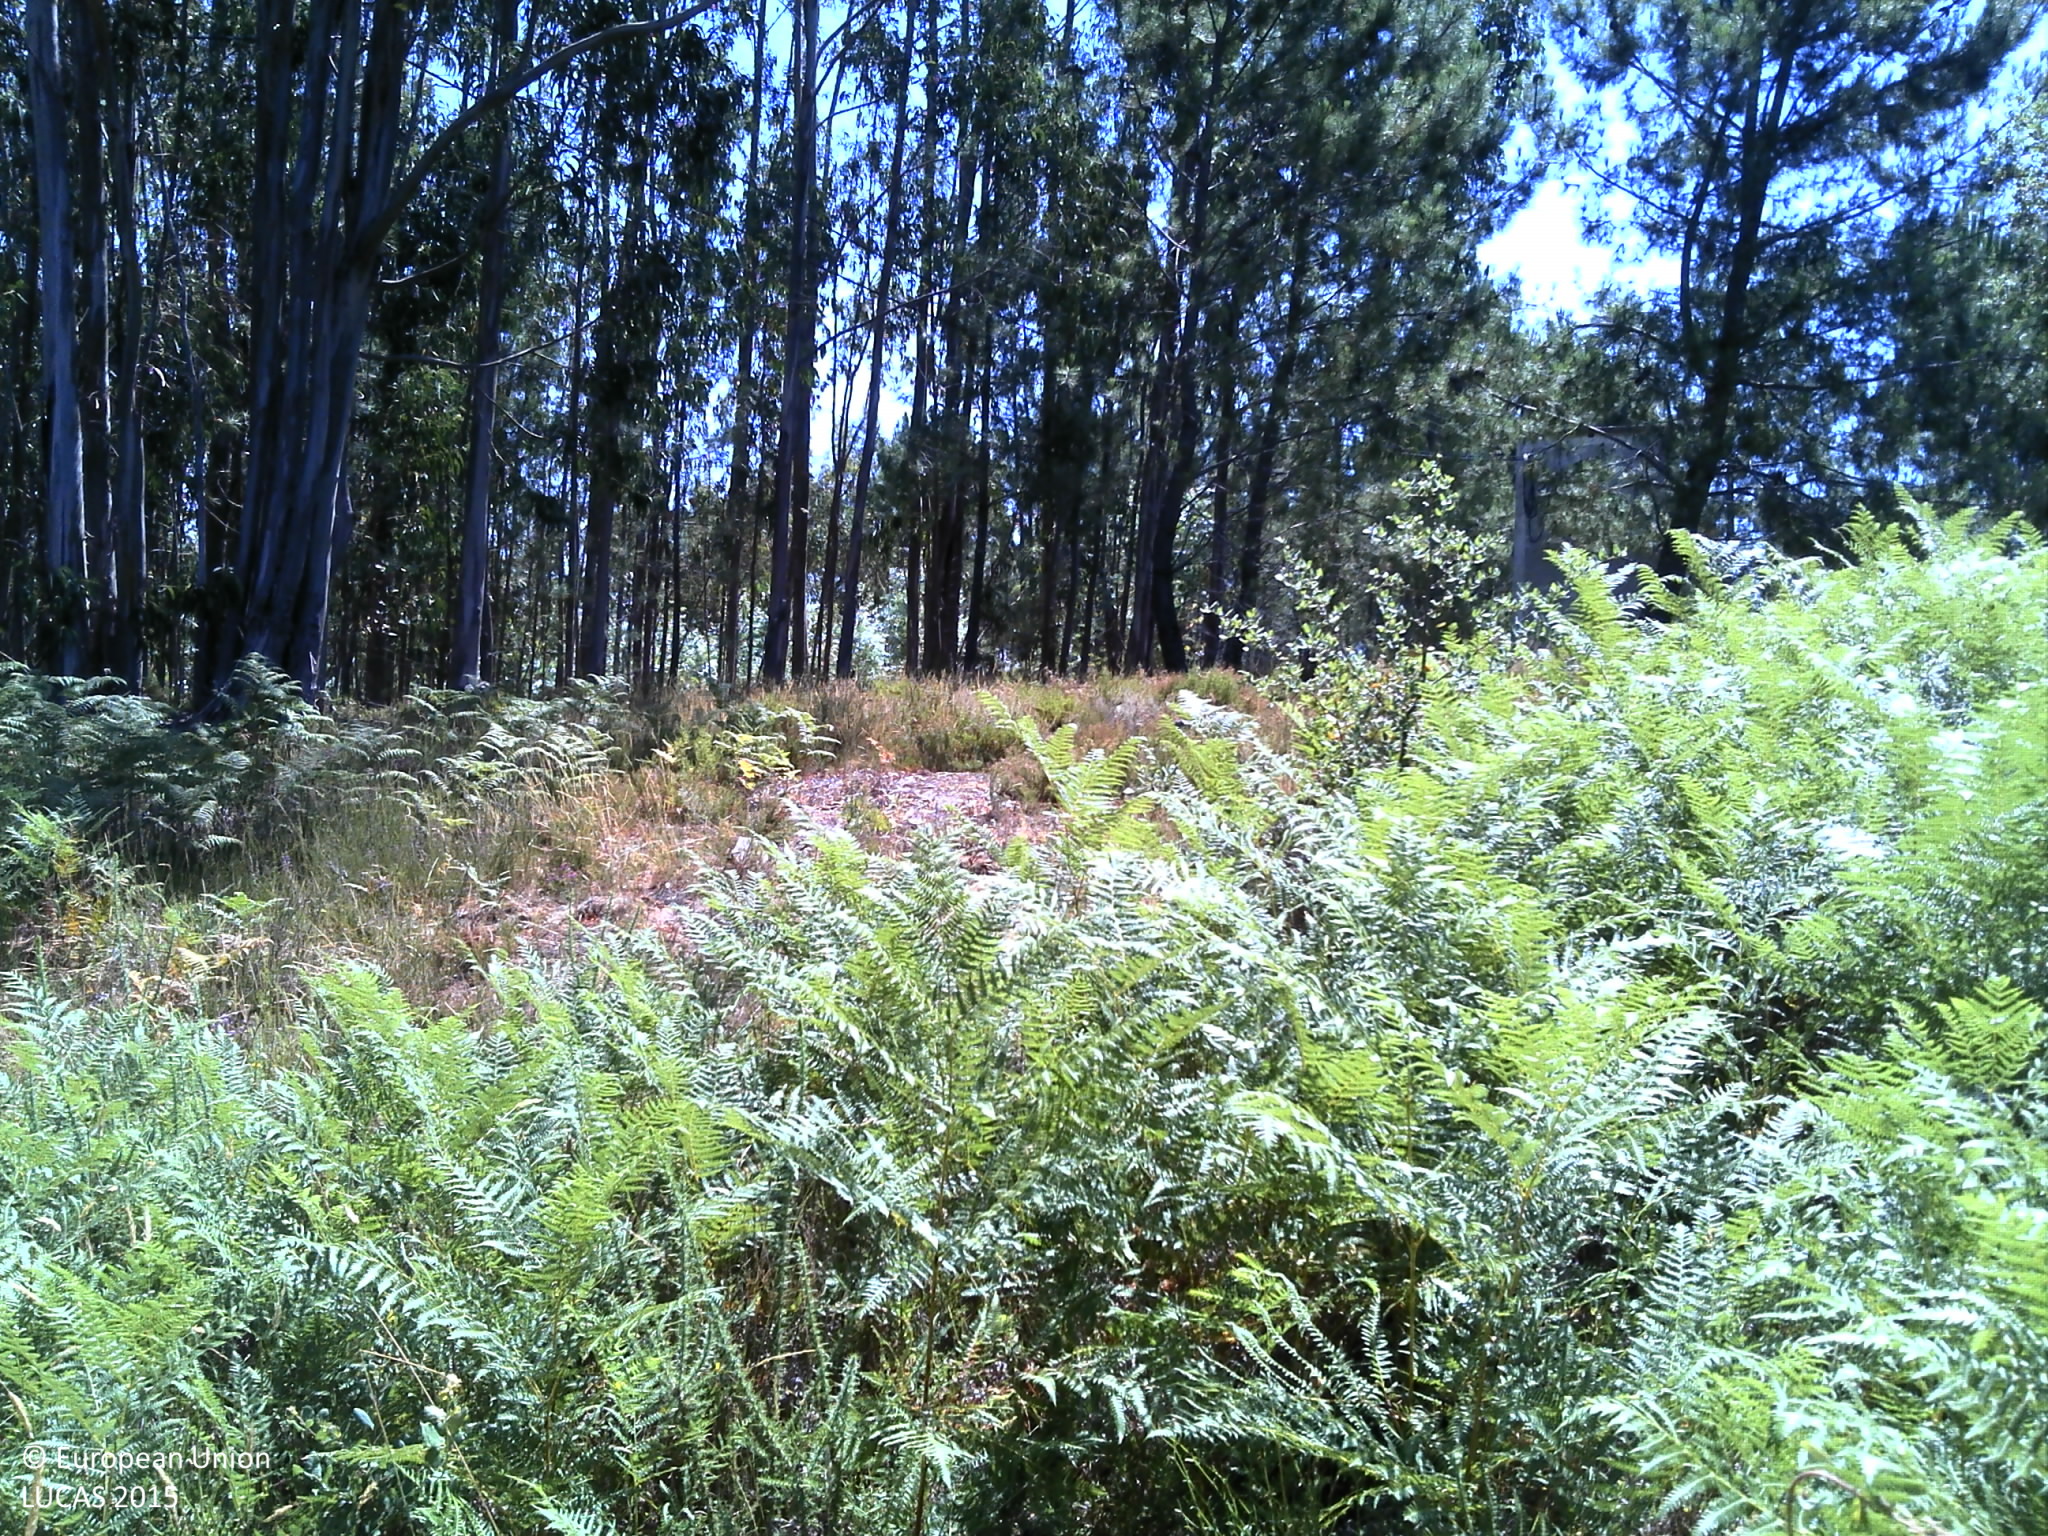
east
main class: Shrubland
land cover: Shrubland with sparse tree cover
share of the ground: > 75 %
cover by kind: shrubs 90 %, broadleaved forest trees 5 %, unconsolidated bare surface 5 %
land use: Abandoned areas
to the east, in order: Shrubland with sparse tree cover; Shrubland without tree cover; Broadleaved woodland; Electric lines; Broadleaved woodland; Electric lines; Spontaneously vegetated surfaces; Electric lines; Paved roads, cycling and walking lanes; Broadleaved woodland; Ditches and canals; Paved roads, cycling and walking lanes; Shruby margins; Broadleaved woodland; Electric lines; Broadleaved woodland
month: July
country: PT
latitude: 39.9881
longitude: -8.2144
